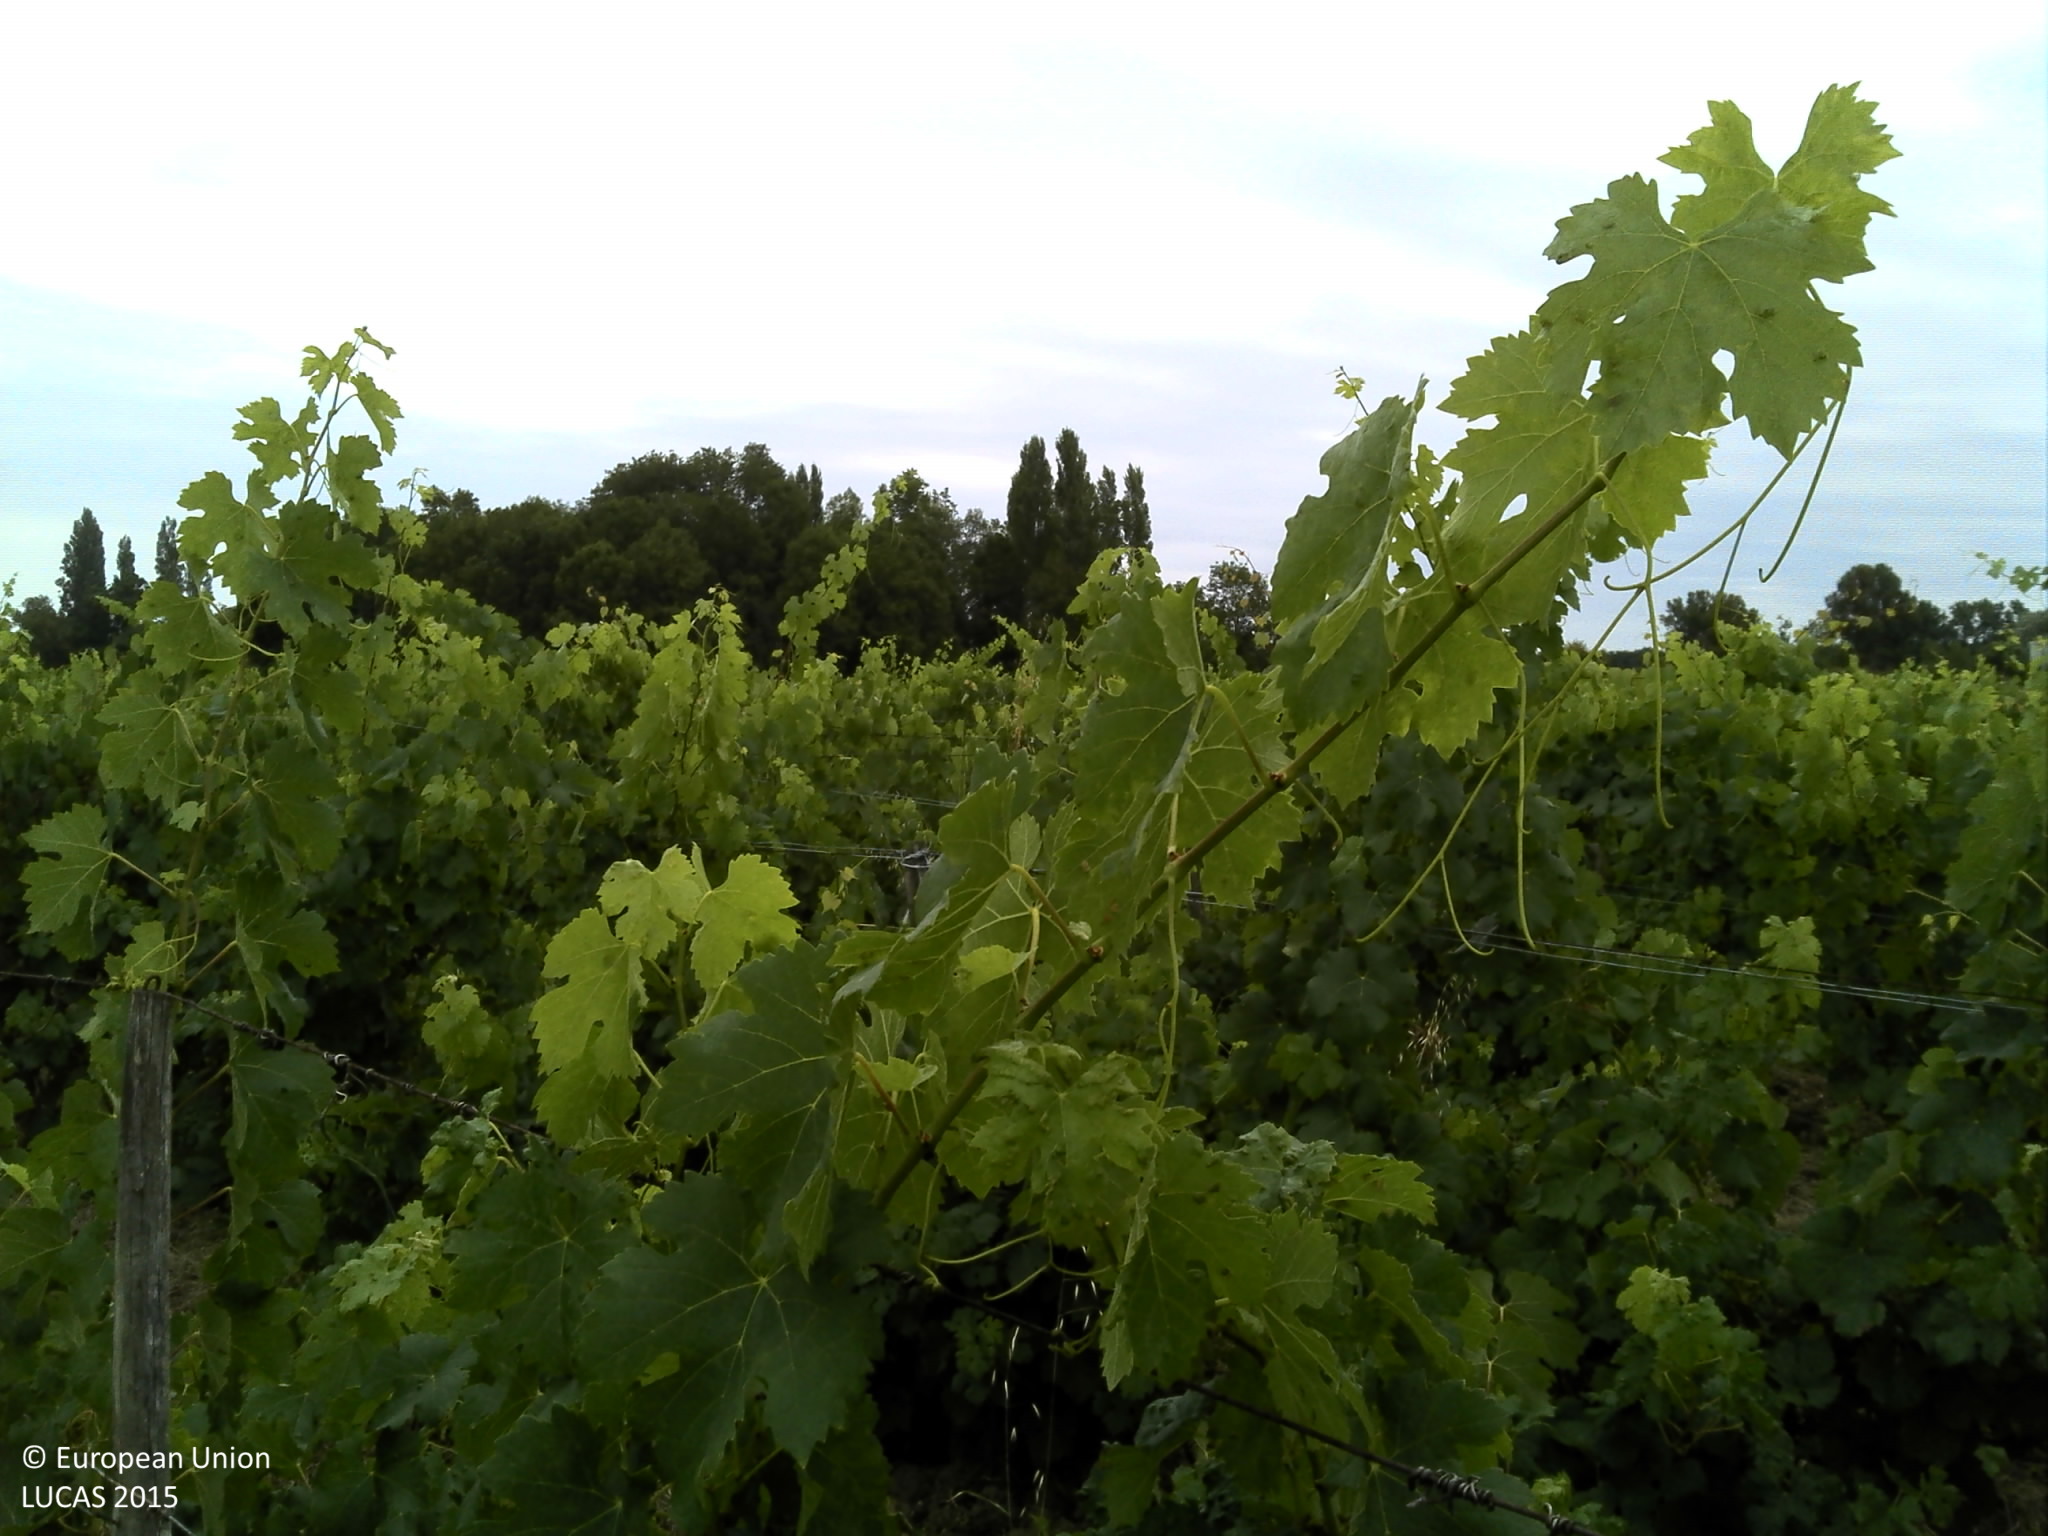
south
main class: Cropland
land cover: Vineyards
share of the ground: 50 - 75 %
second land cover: Grassland without tree/shrub cover
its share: 25 - 50 %
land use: Agriculture (excluding fallow land and kitchen gardens)
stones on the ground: < 10 %
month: August
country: FR
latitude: 45.1697
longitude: -0.5938
